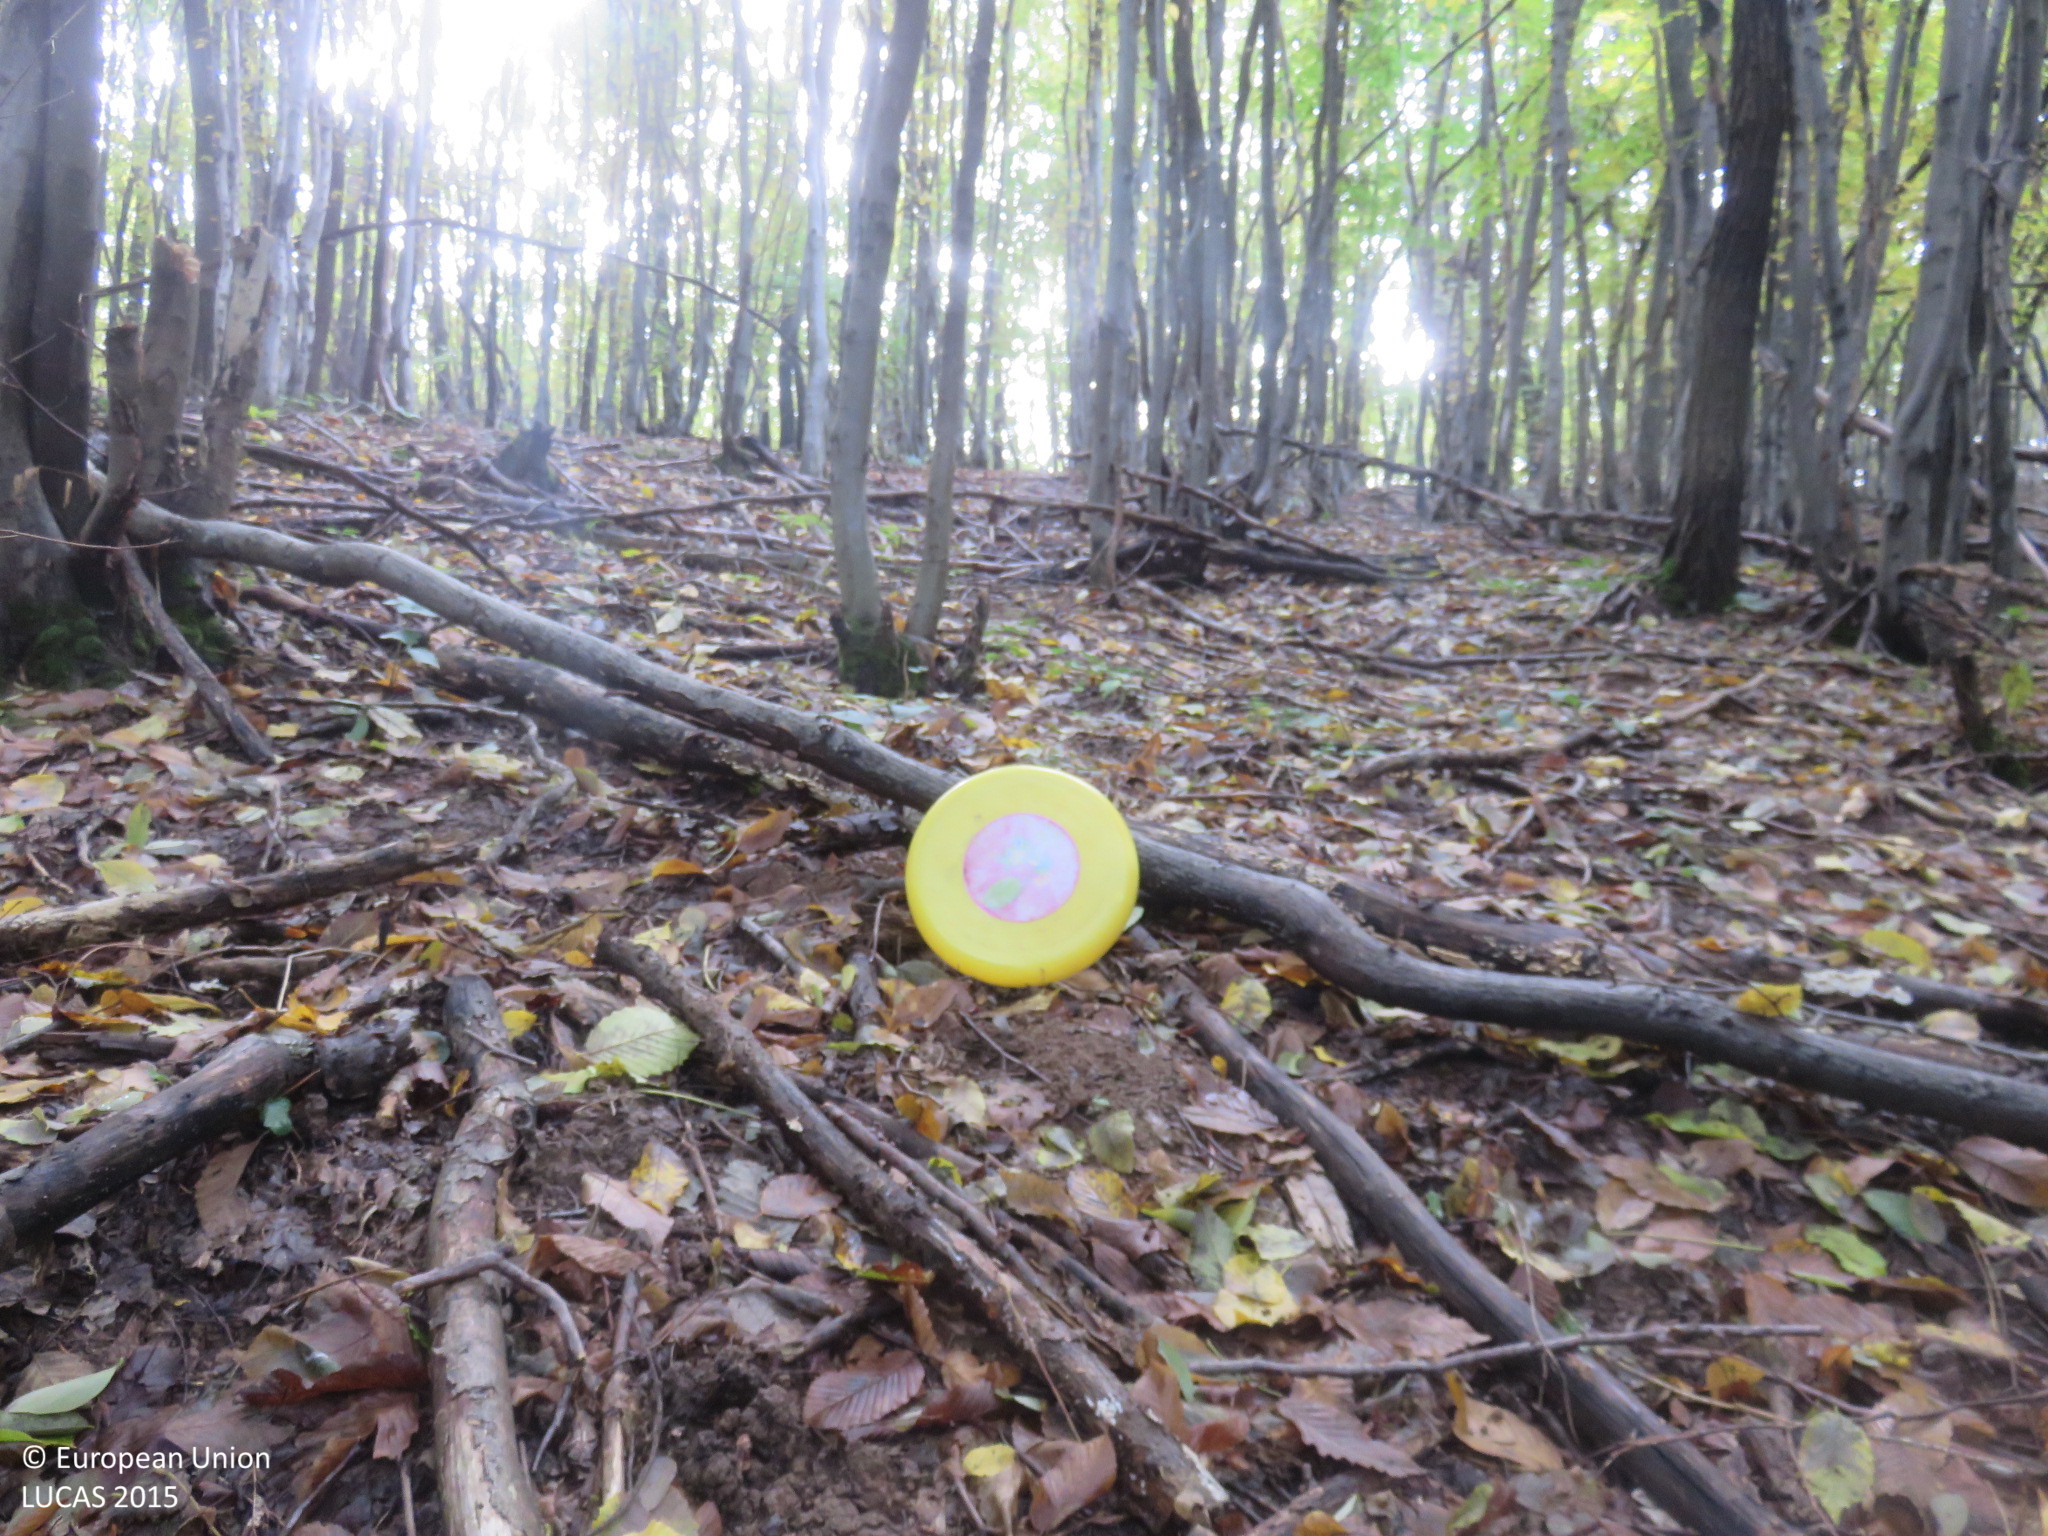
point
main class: Woodland
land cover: Broadleaved woodland
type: beech forest
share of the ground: > 75 %
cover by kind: broadleaved forest trees 95 %, unconsolidated bare surface 5 %
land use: Forestry
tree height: > 5 m
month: October
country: BG
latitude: 42.9648
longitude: 25.2104
